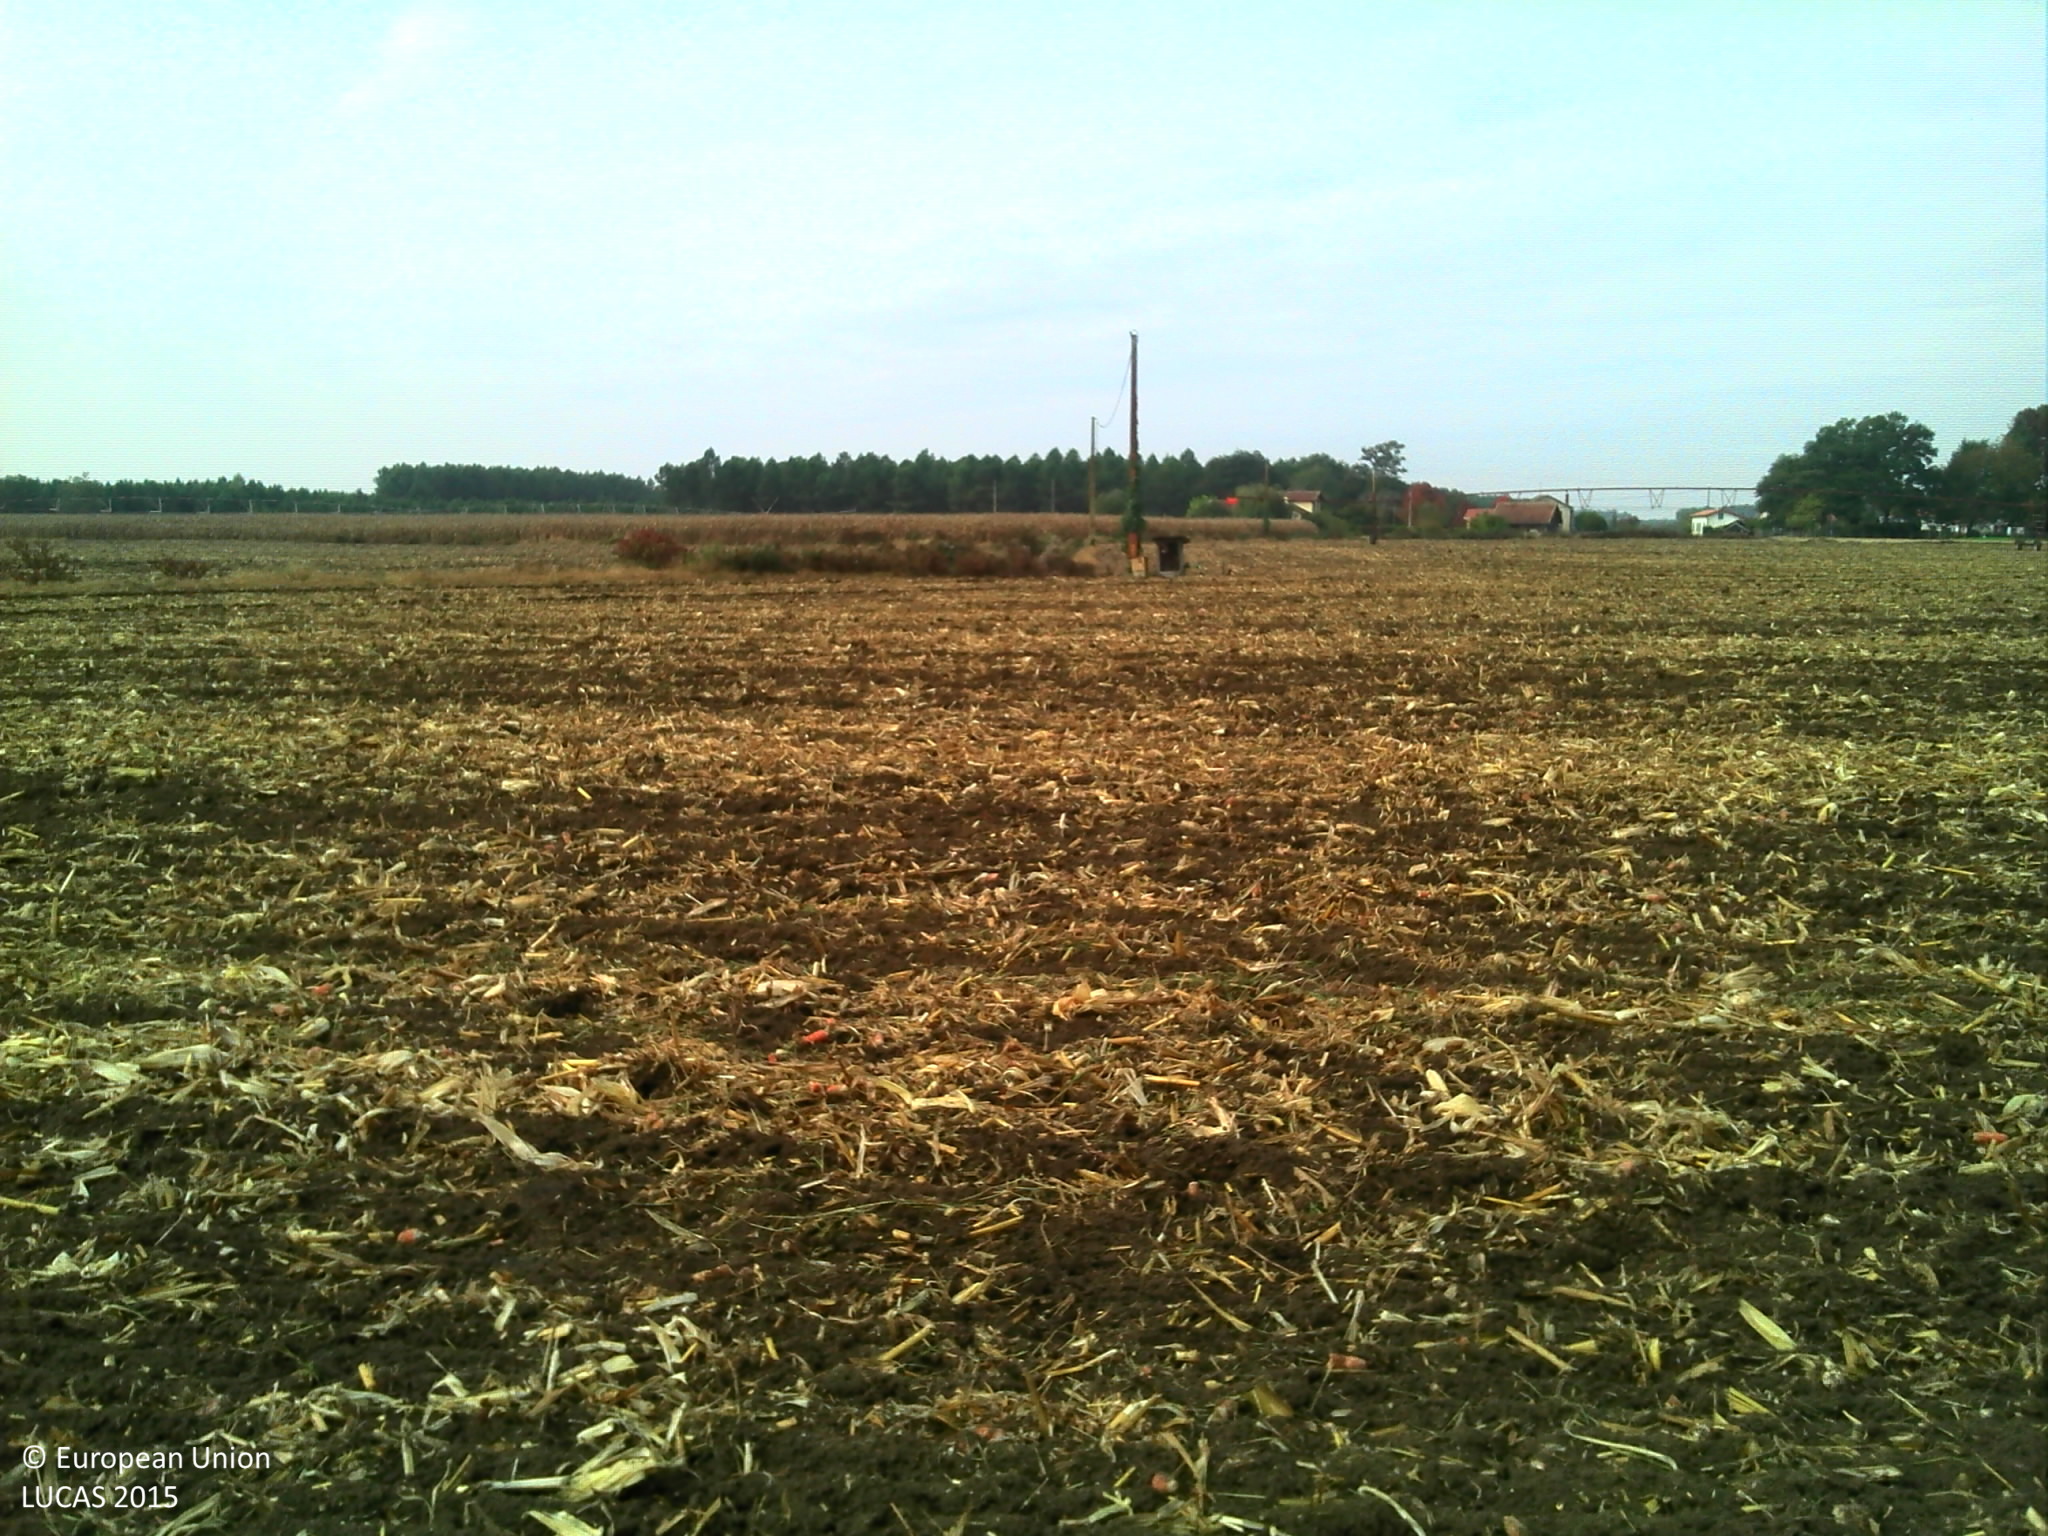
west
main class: Cropland
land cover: Maize
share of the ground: > 75 %
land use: Agriculture (excluding fallow land and kitchen gardens)
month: October
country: FR
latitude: 43.8757
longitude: -0.8042
